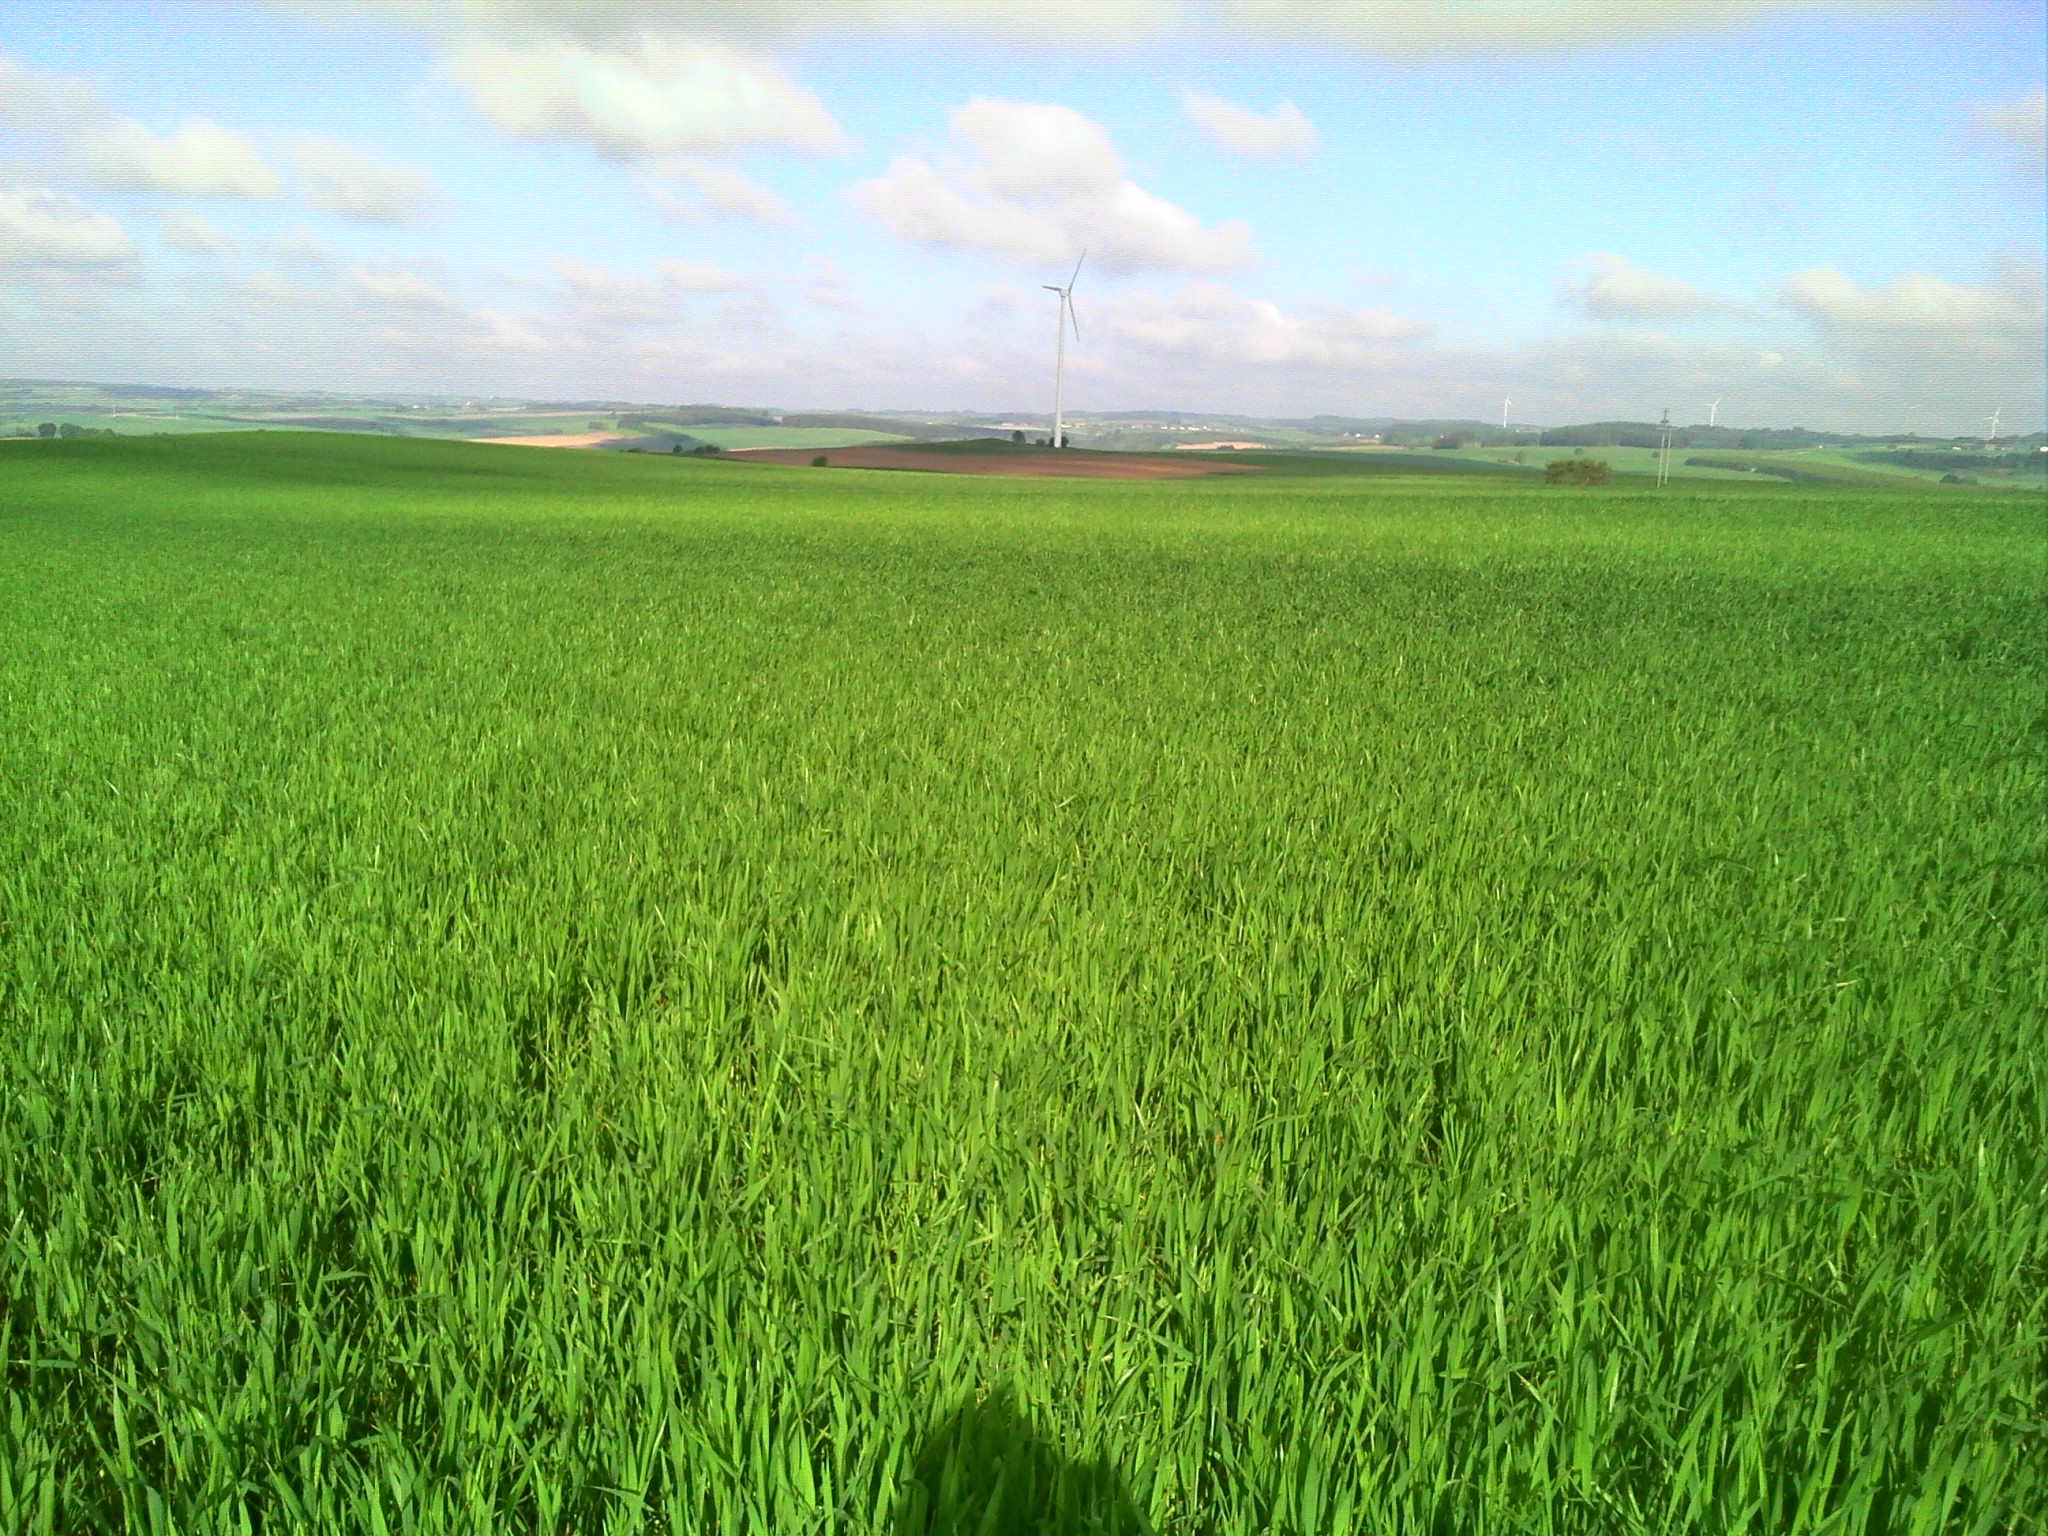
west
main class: Cropland
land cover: Common wheat
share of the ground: > 75 %
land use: Agriculture (excluding fallow land and kitchen gardens)
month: May
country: LU
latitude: 50.0199
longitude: 5.8817
